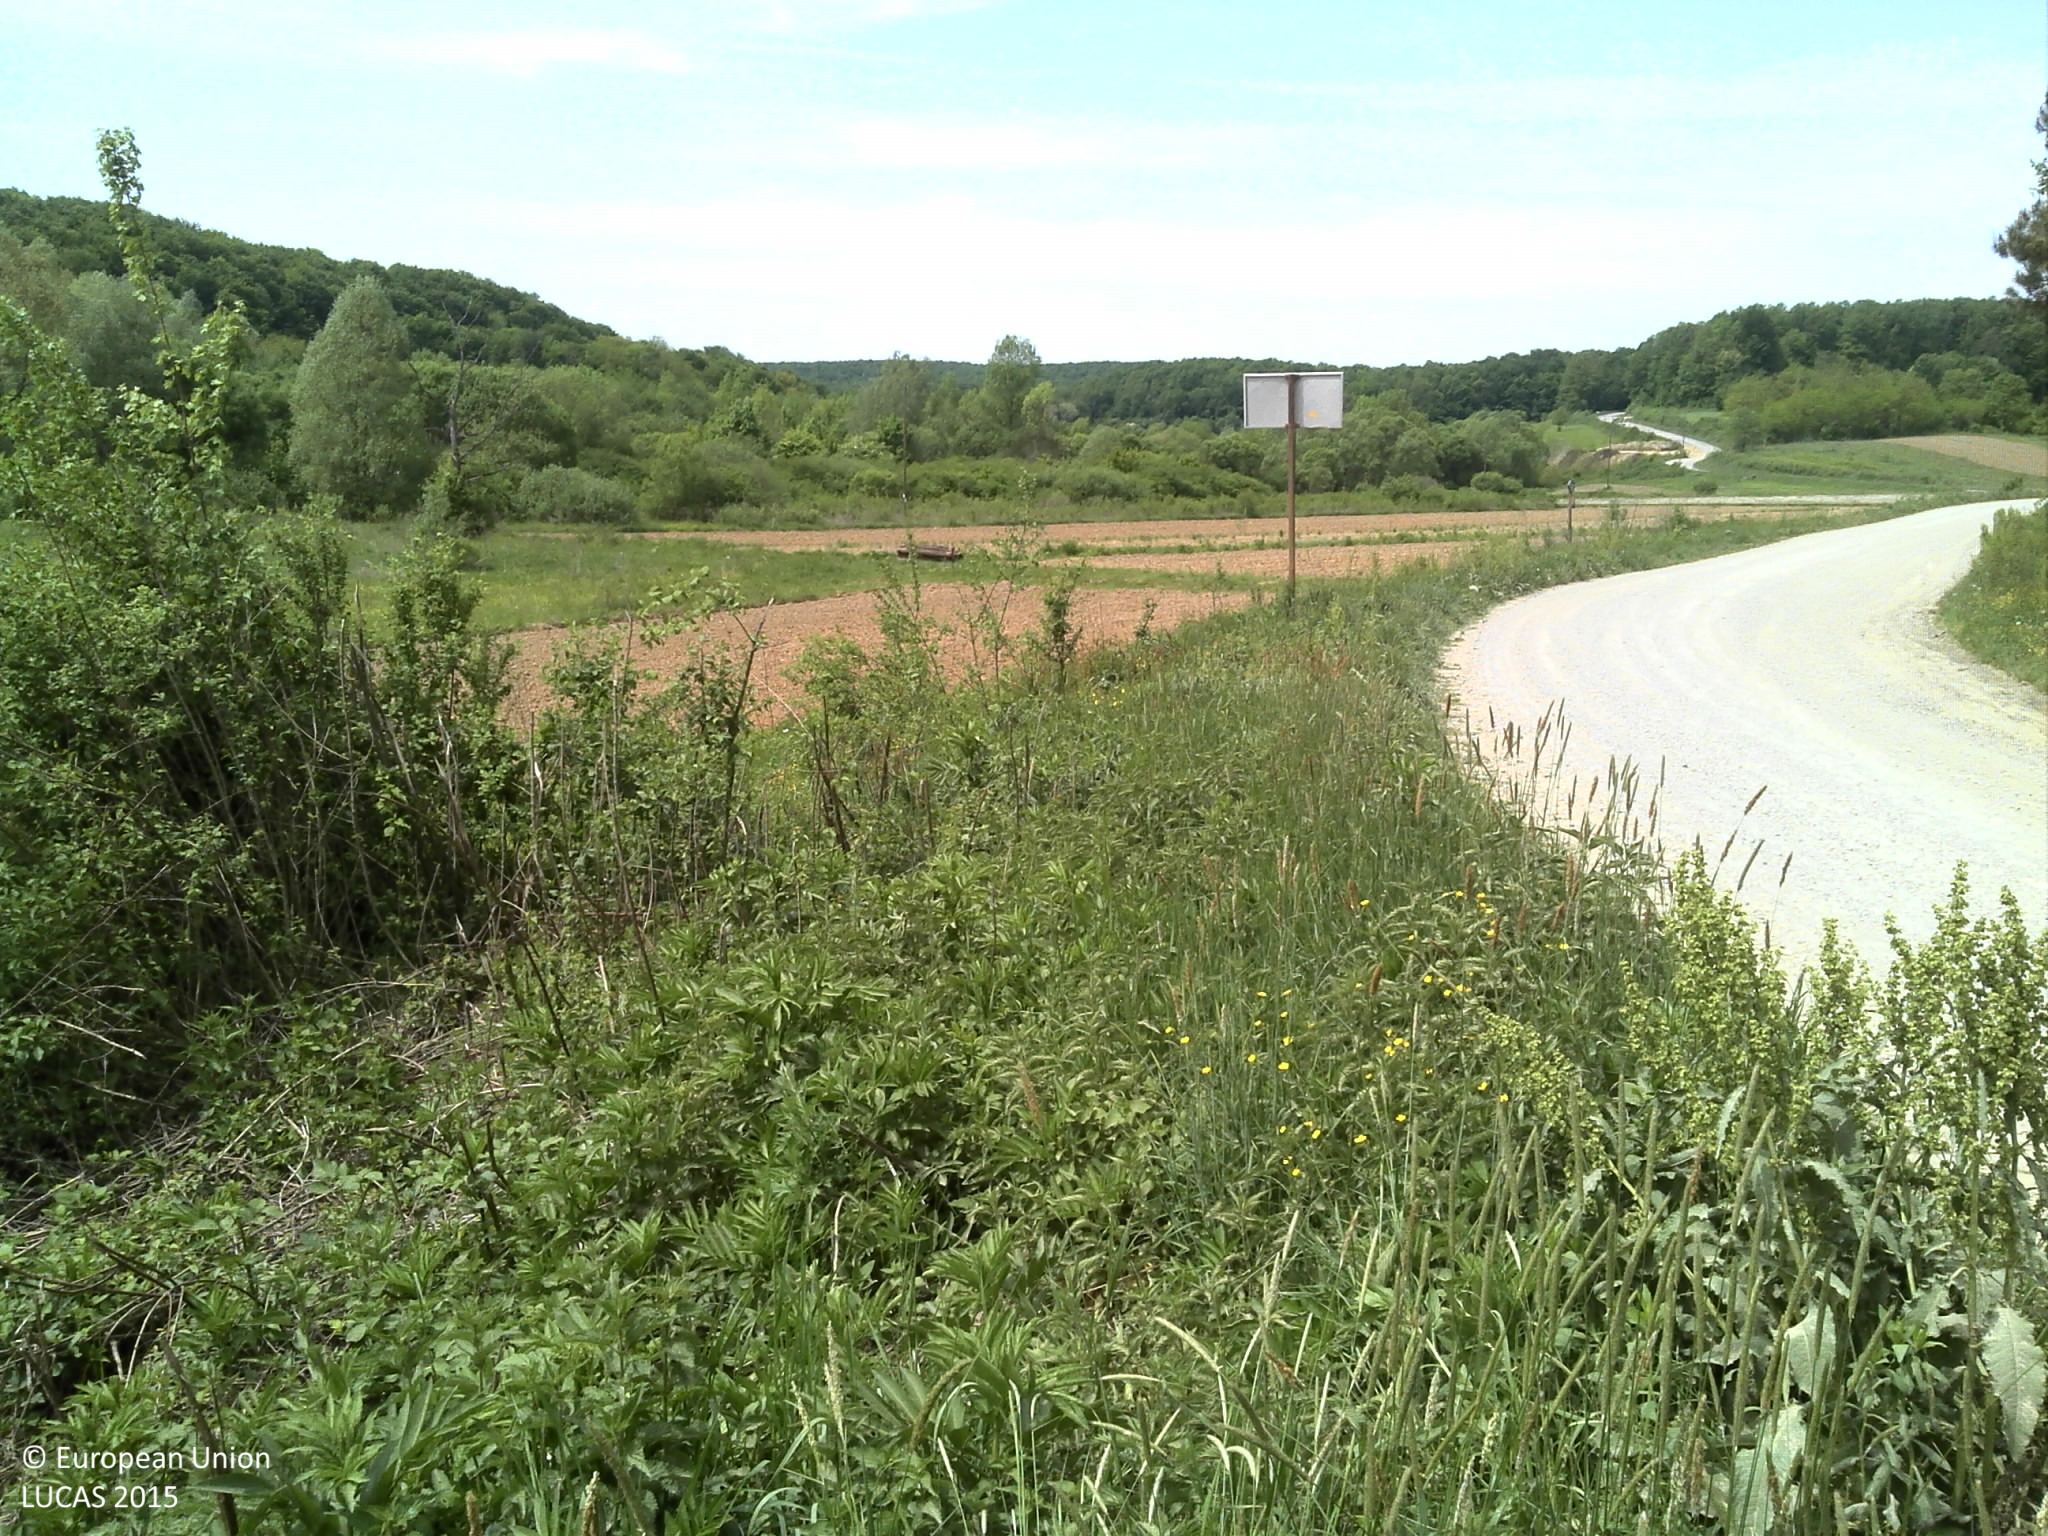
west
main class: Shrubland
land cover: Shrubland with sparse tree cover
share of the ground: > 75 %
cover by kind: shrubs 95 %, broadleaved forest trees 5 %
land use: Semi-natural and natural areas not in use
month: May
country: HR
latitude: 45.3332
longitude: 18.1575
